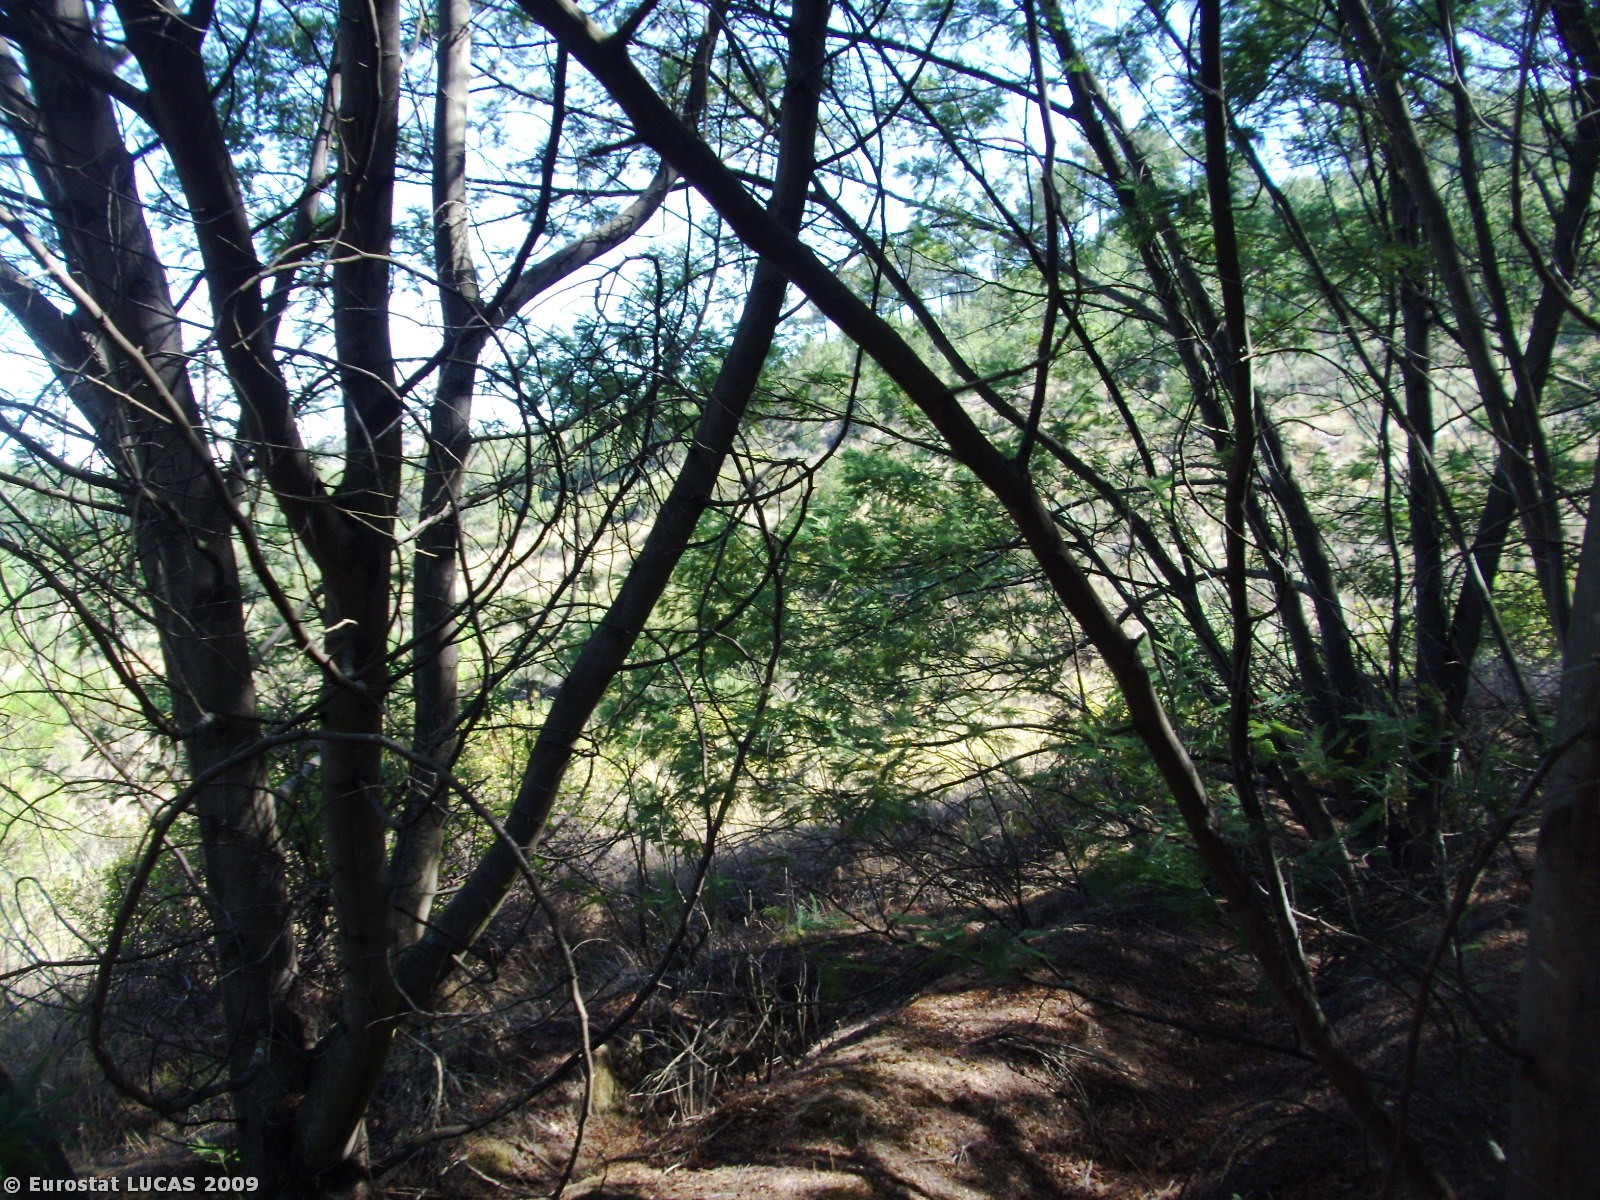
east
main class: Woodland
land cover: Broadleaved woodland
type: mesophytic deciduous forest
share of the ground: > 75 %
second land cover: Bare land
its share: < 10 %
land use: Forestry
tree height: > 5 m
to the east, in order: Broadleaved woodland; Bare land; Broadleaved woodland; Shrubland with sparse tree cover; Tracks; Shrubland with sparse tree cover; Tracks; Shrubland with sparse tree cover
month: July
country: PT
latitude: 40.3931
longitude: -7.3168
